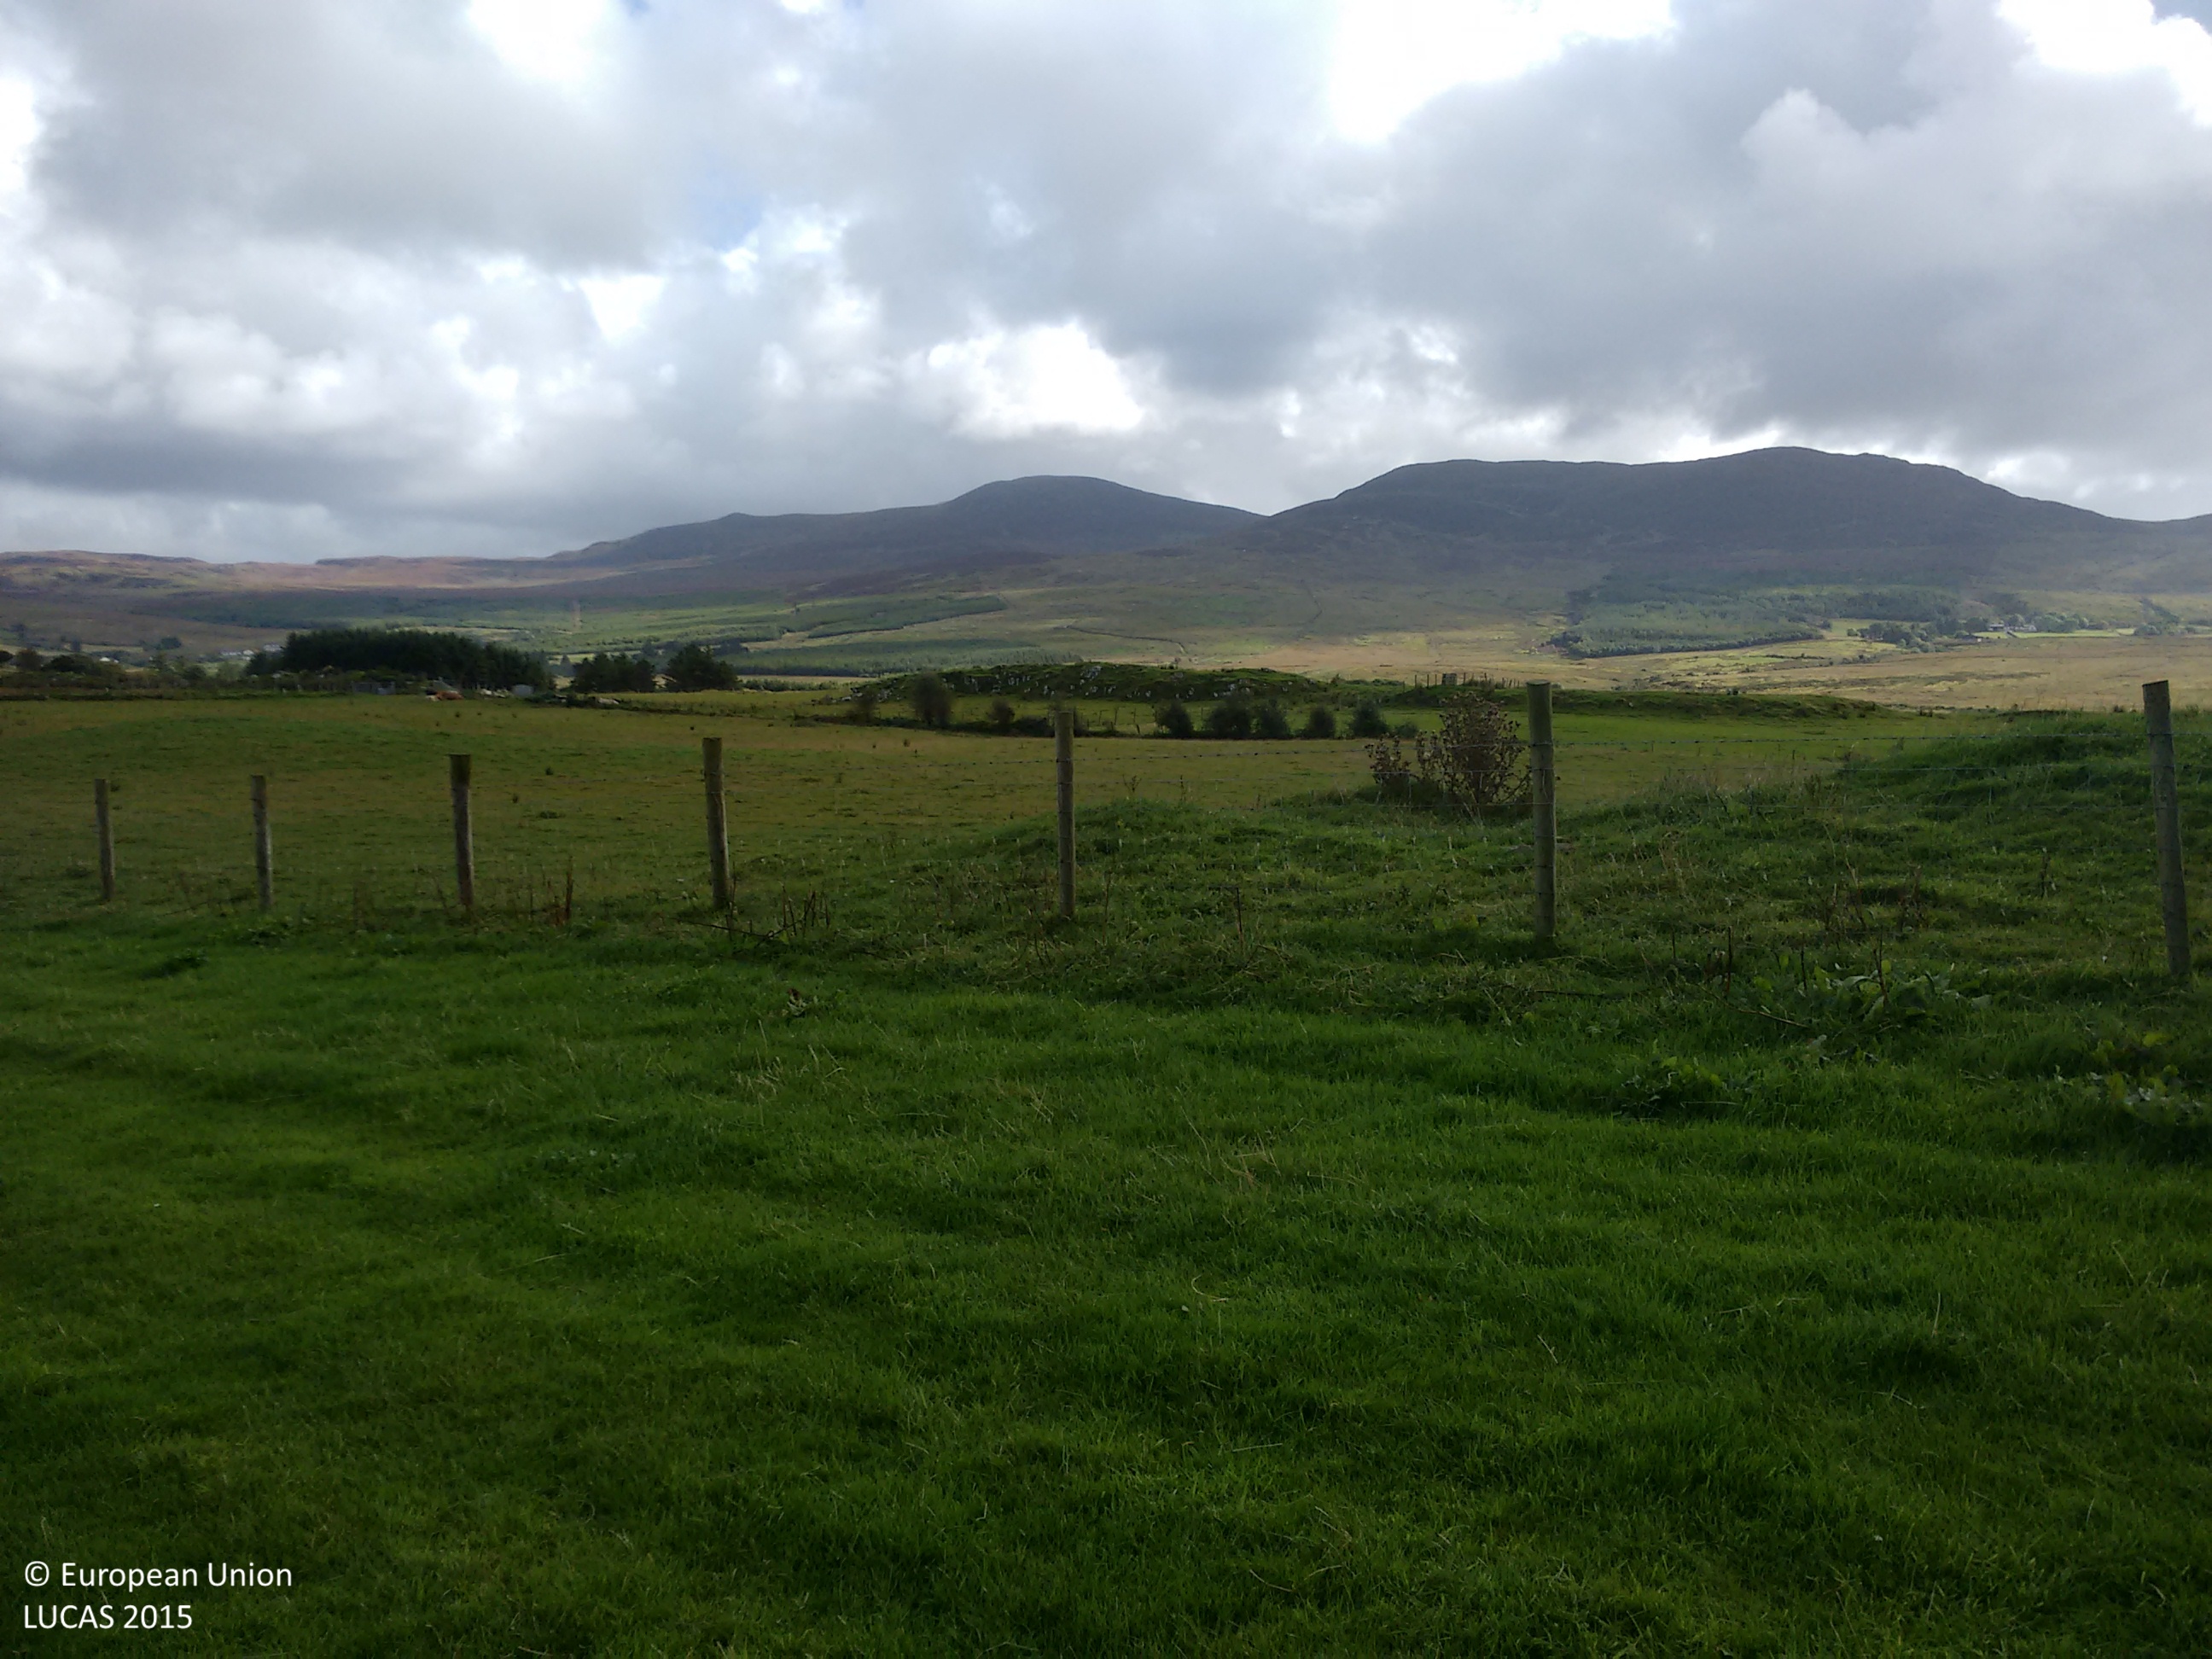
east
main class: Grassland
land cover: Grassland without tree/shrub cover
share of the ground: > 75 %
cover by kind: herbaceous plants 100 %
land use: Agriculture (excluding fallow land and kitchen gardens)
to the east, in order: Grassland without tree/shrub cover; Fences; Grassland without tree/shrub cover; Abandoned hedges; Fences; Grassland without tree/shrub cover; Fences; Grassland without tree/shrub cover; Fences; Grassland without tree/shrub cover
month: September
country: IE
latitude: 55.1859
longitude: -7.4111
